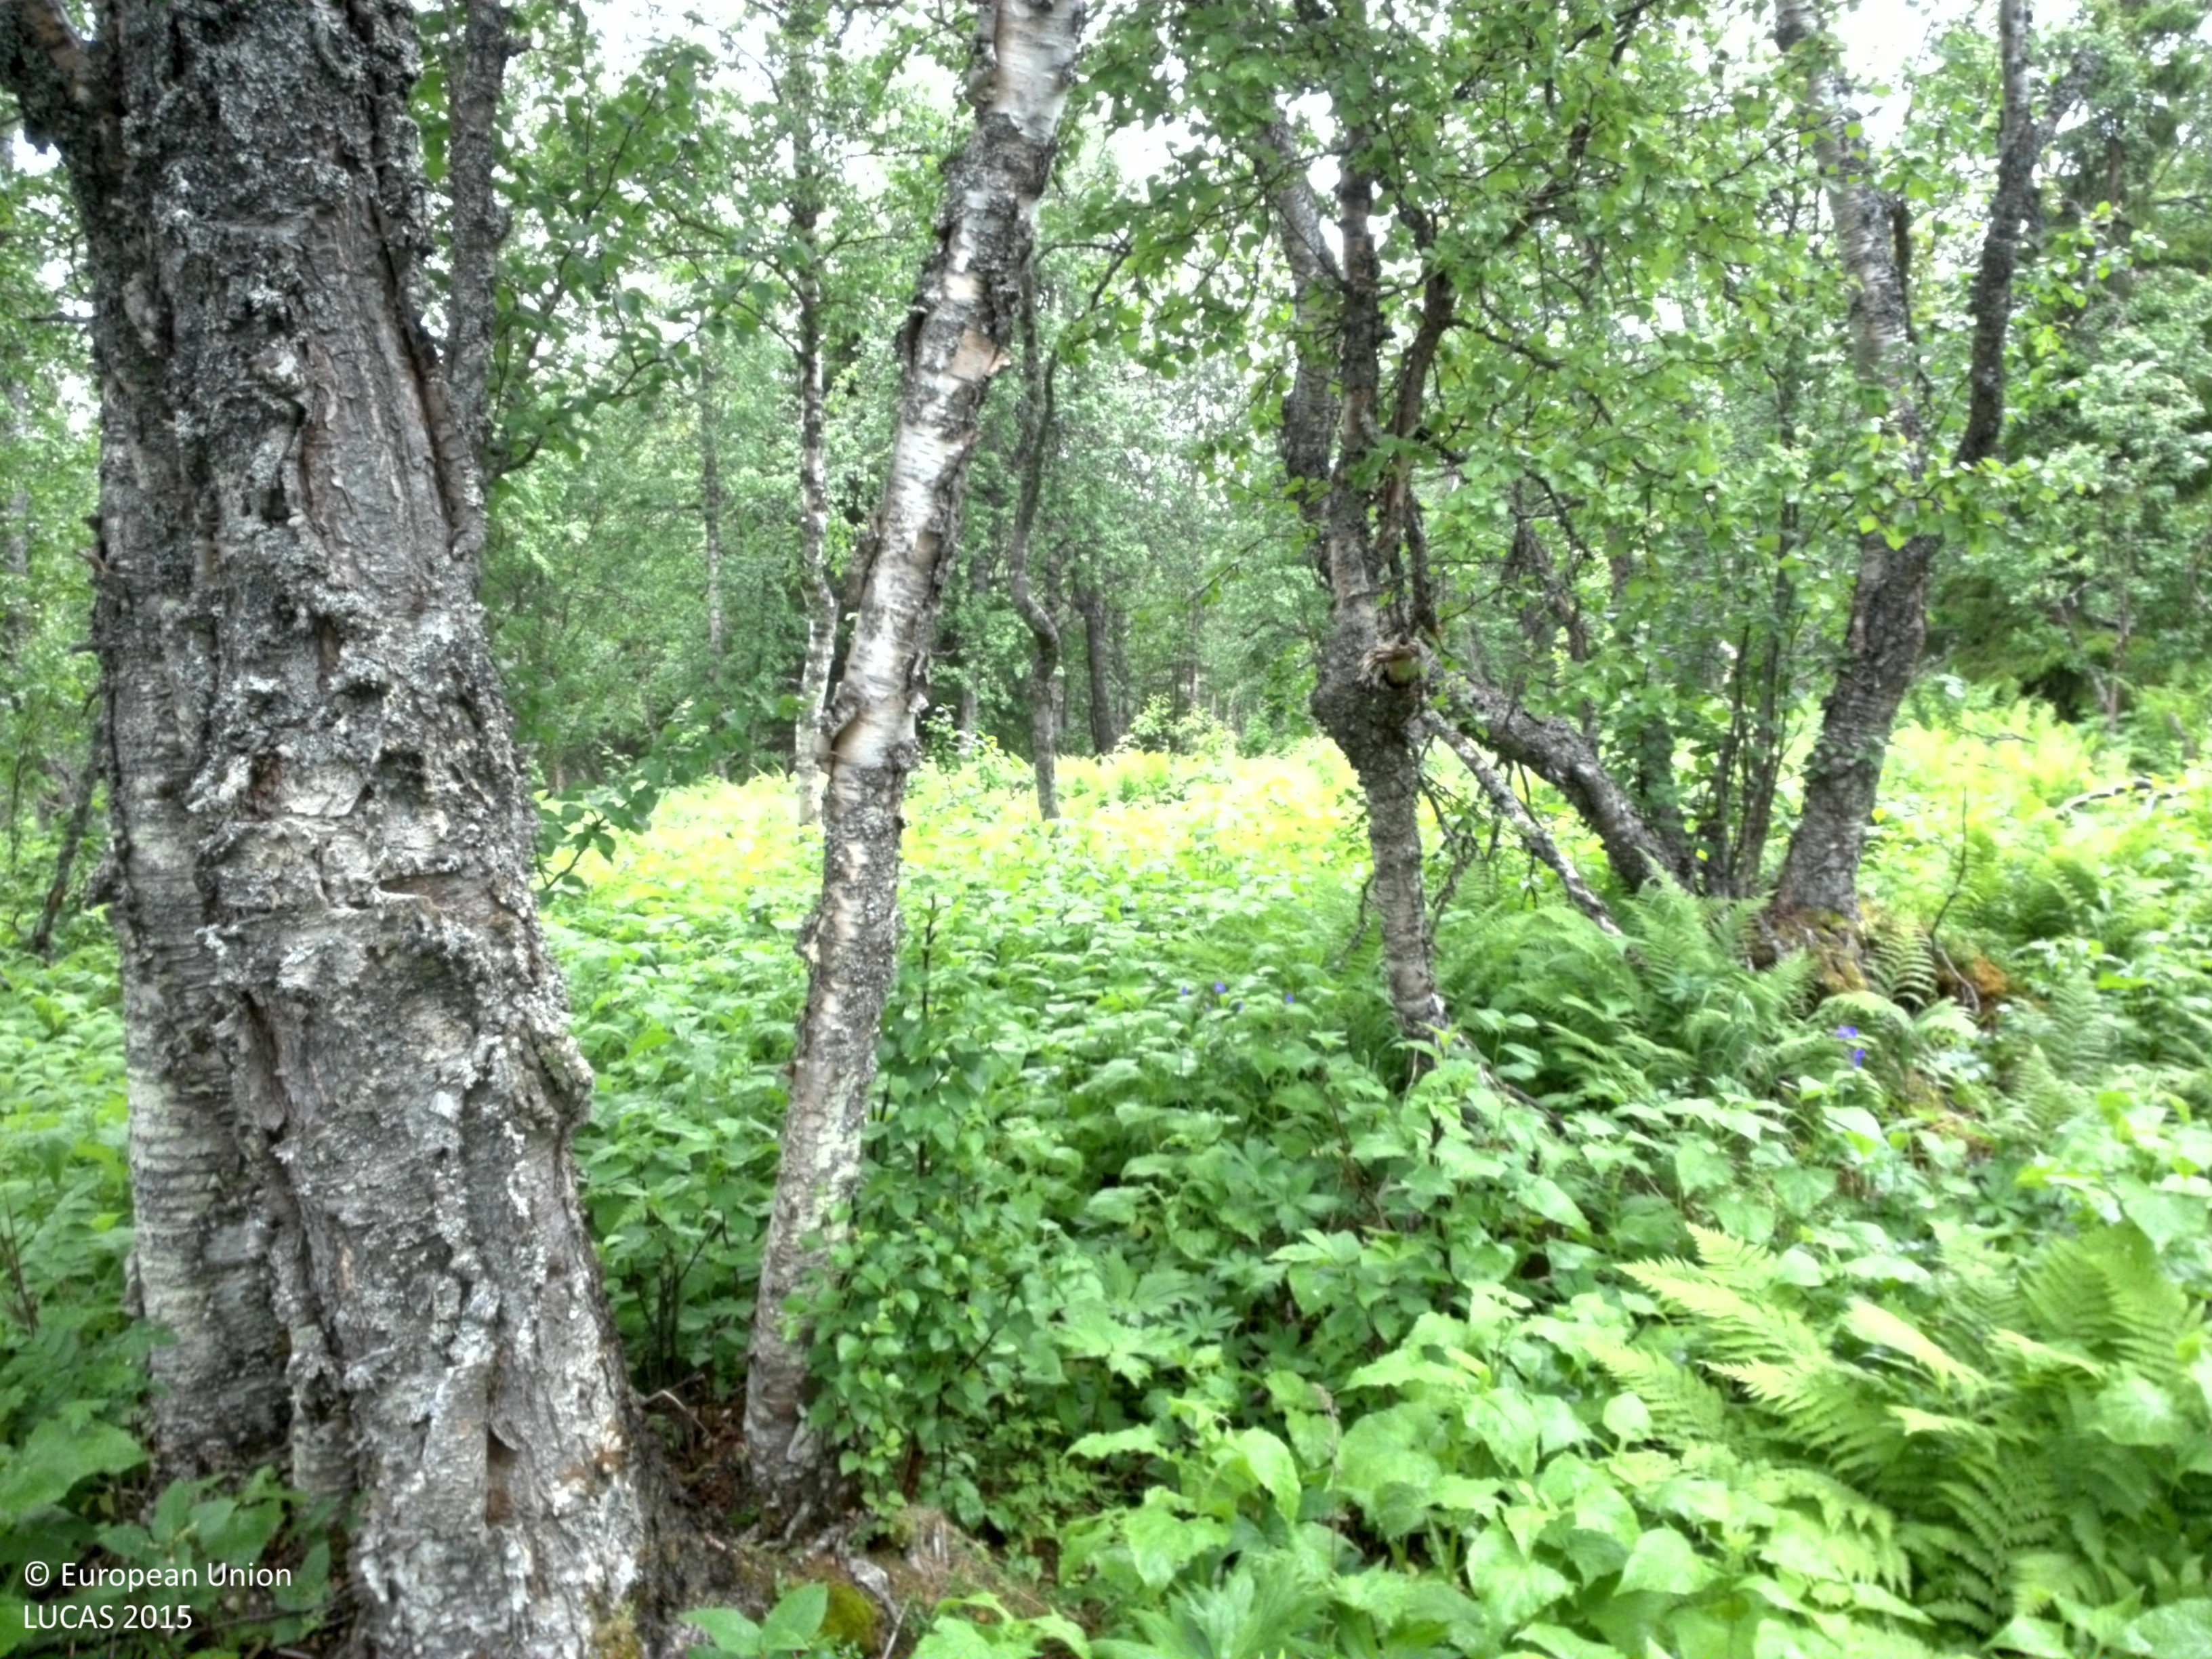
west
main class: Woodland
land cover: Broadleaved woodland
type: non-riverine alder, birch or aspen forest
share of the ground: 25 - 50 %
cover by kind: herbaceous plants 75 %, broadleaved forest trees 25 %
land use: Semi-natural and natural areas not in use
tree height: > 5 m
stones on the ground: 10 - 25 %
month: August
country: SE
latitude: 65.2759
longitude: 15.6438
